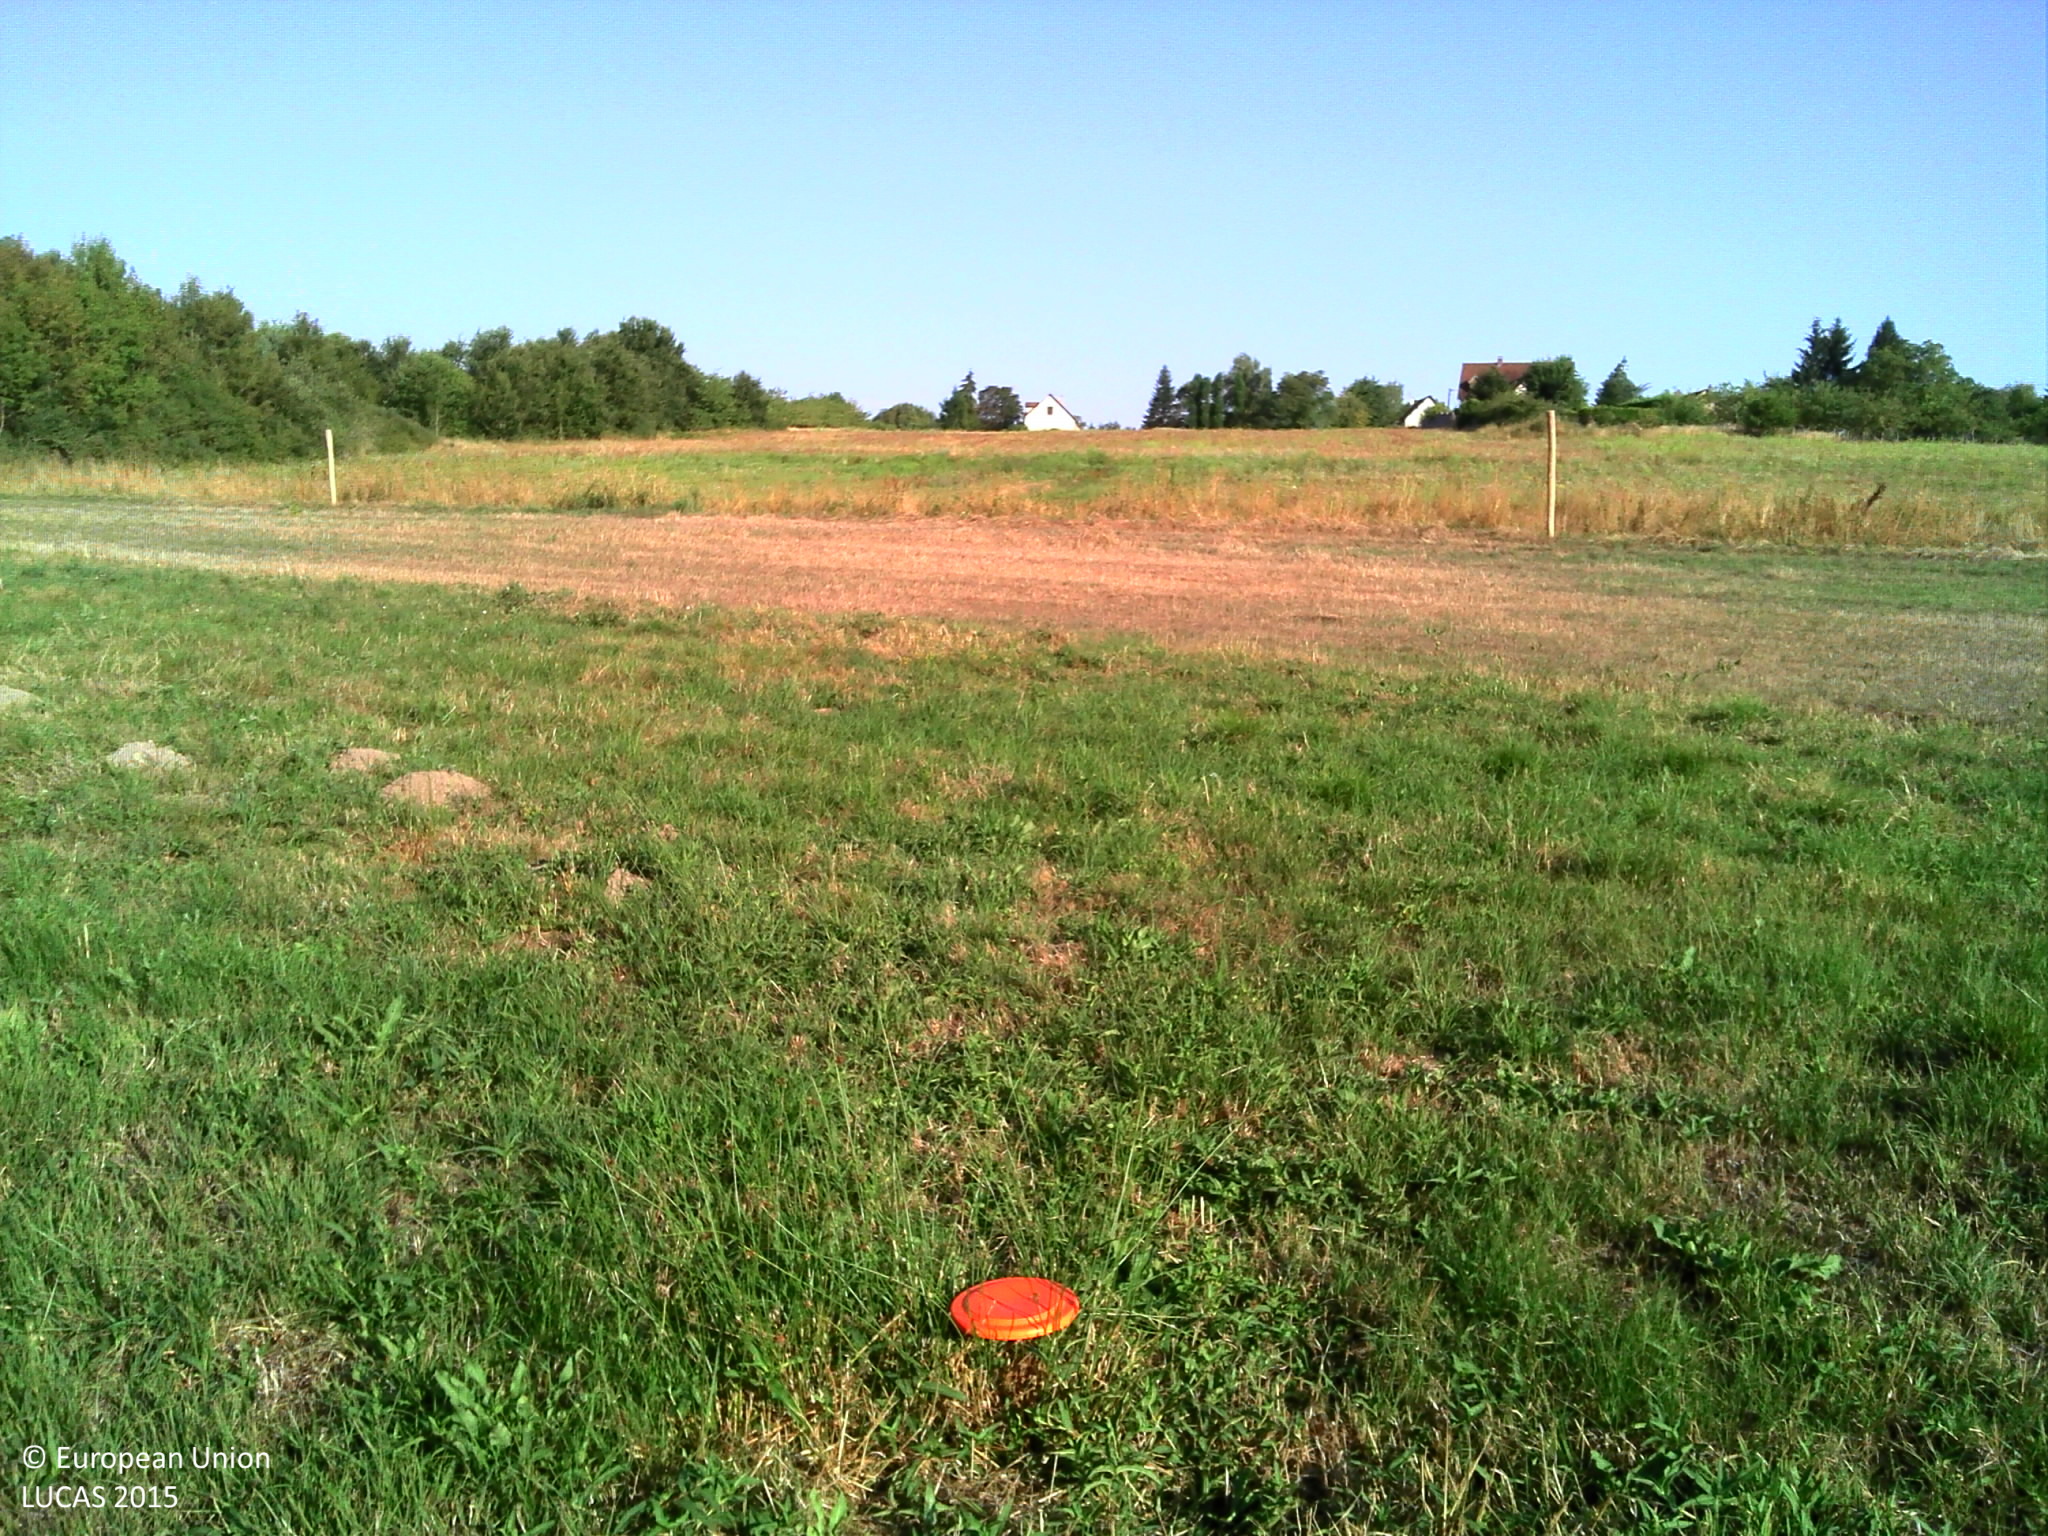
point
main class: Grassland
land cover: Grassland without tree/shrub cover
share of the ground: > 75 %
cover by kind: herbaceous plants 100 %
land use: Agriculture (excluding fallow land and kitchen gardens)
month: August
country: FR
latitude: 47.8130
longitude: 3.4649
